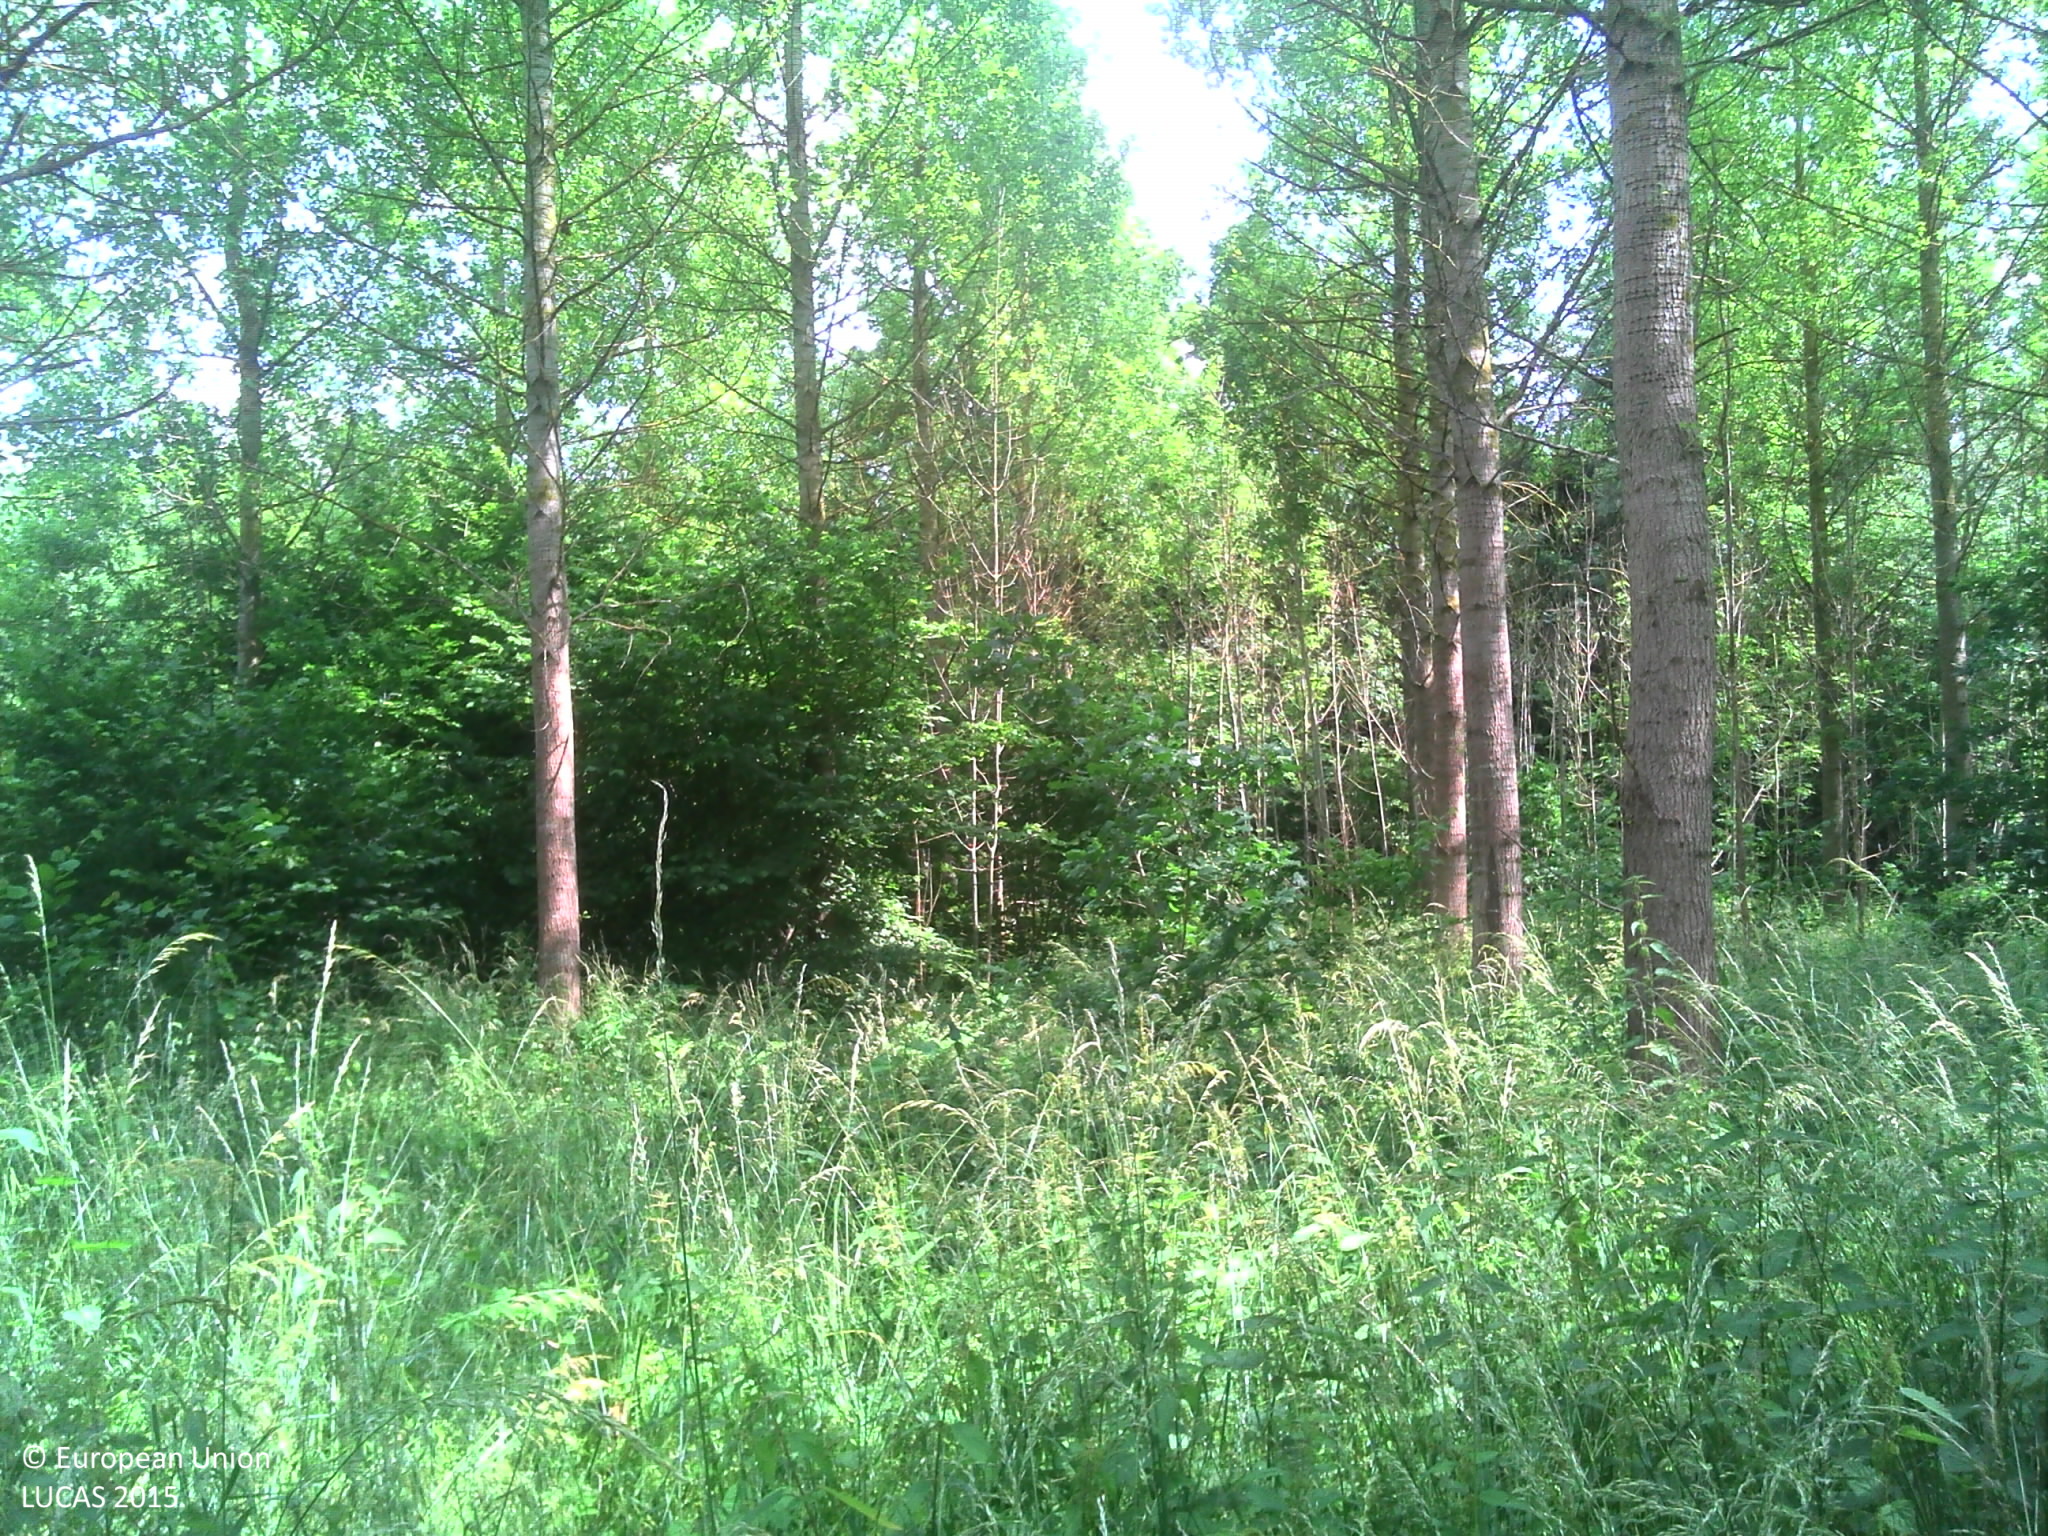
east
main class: Woodland
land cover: Broadleaved woodland
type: exotic forest
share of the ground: > 75 %
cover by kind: broadleaved forest trees 85 %, shrubs 10 %, herbaceous plants 5 %
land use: Forestry
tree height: > 5 m
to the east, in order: Broadleaved woodland; Grassland with sparse tree/shrub cover; Fences; Broadleaved woodland; Tracks; Maize
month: June
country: BE
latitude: 50.9202
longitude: 4.5762
